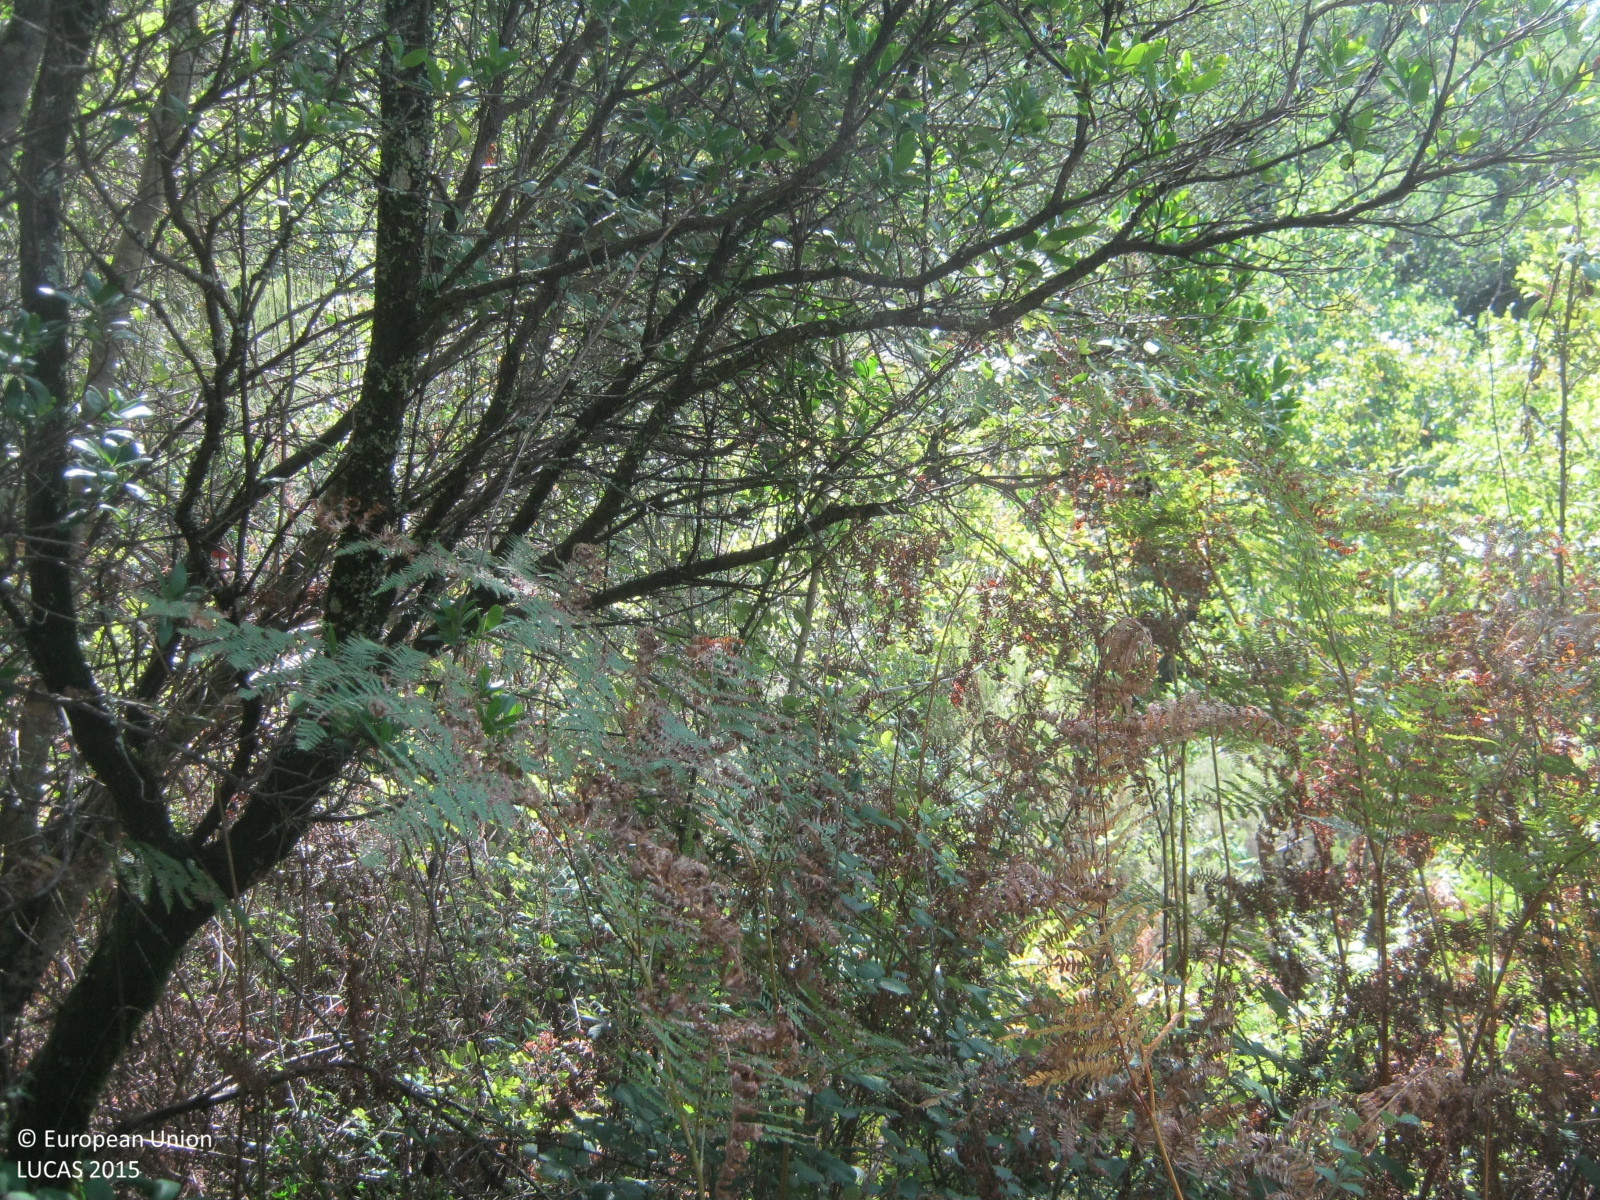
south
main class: Woodland
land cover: Broadleaved woodland
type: broadleaved evergreen forest
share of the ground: > 75 %
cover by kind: broadleaved forest trees 100 %
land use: Semi-natural and natural areas not in use
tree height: > 5 m
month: September
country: GR
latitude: 39.3251
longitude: 21.1006
